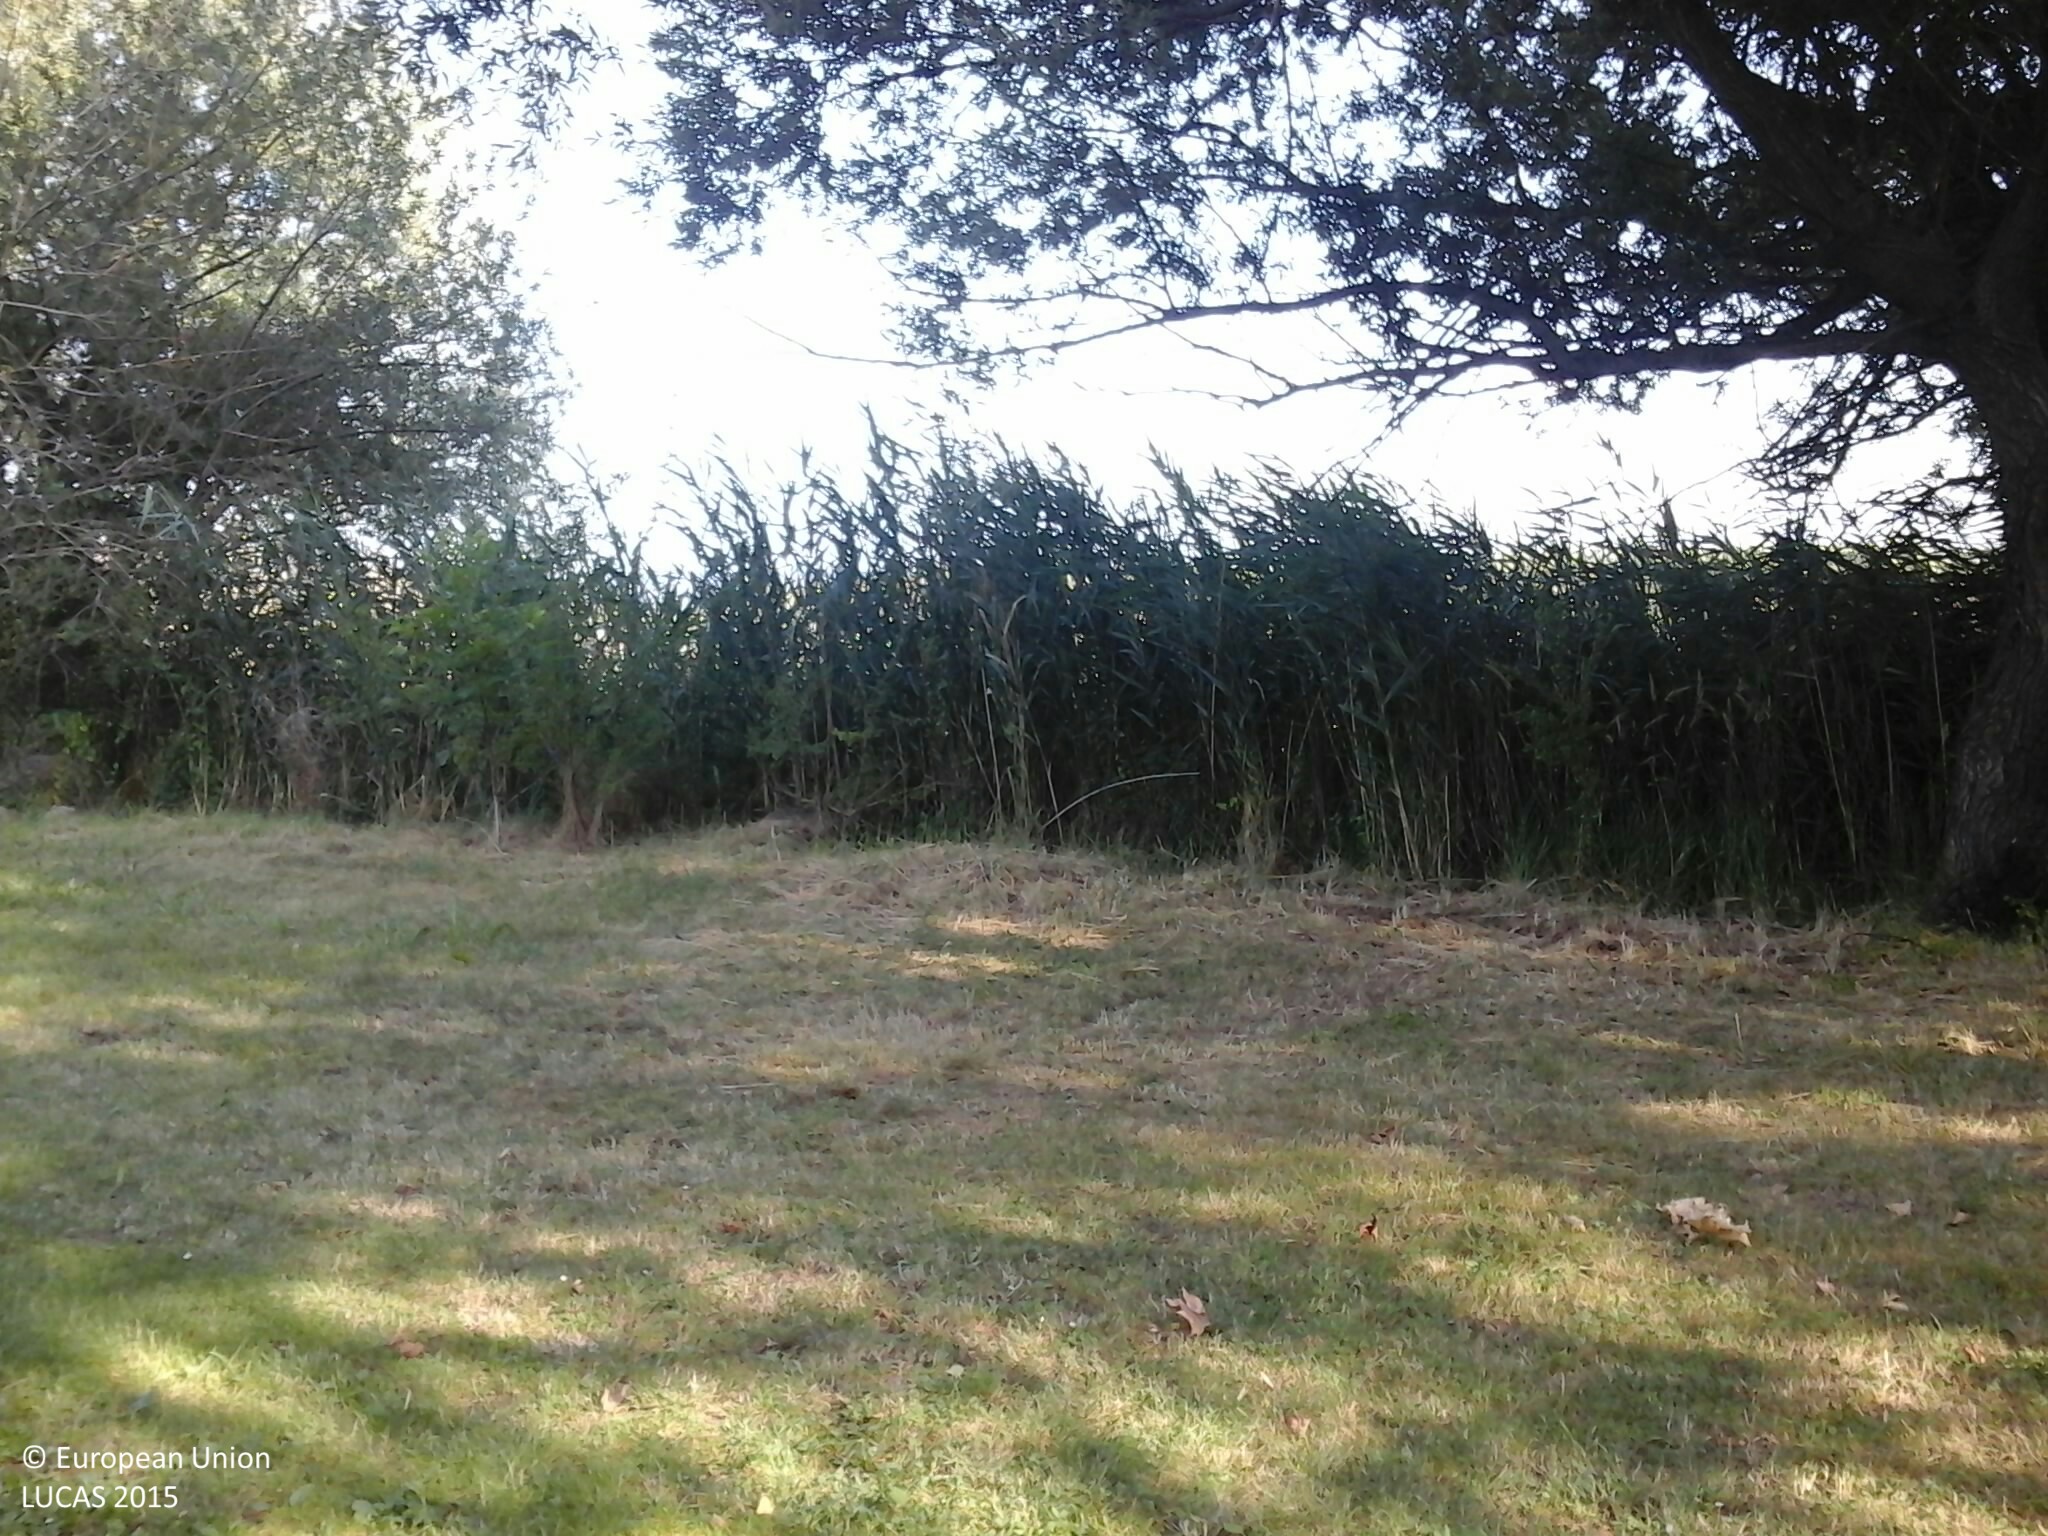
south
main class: Grassland
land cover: Grassland with sparse tree/shrub cover
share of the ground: > 75 %
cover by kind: herbaceous plants 90 %, broadleaved forest trees 5 %, shrubs 5 %
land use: Commerce
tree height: < 5 m
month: July
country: HU
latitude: 46.8828
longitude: 17.7629
